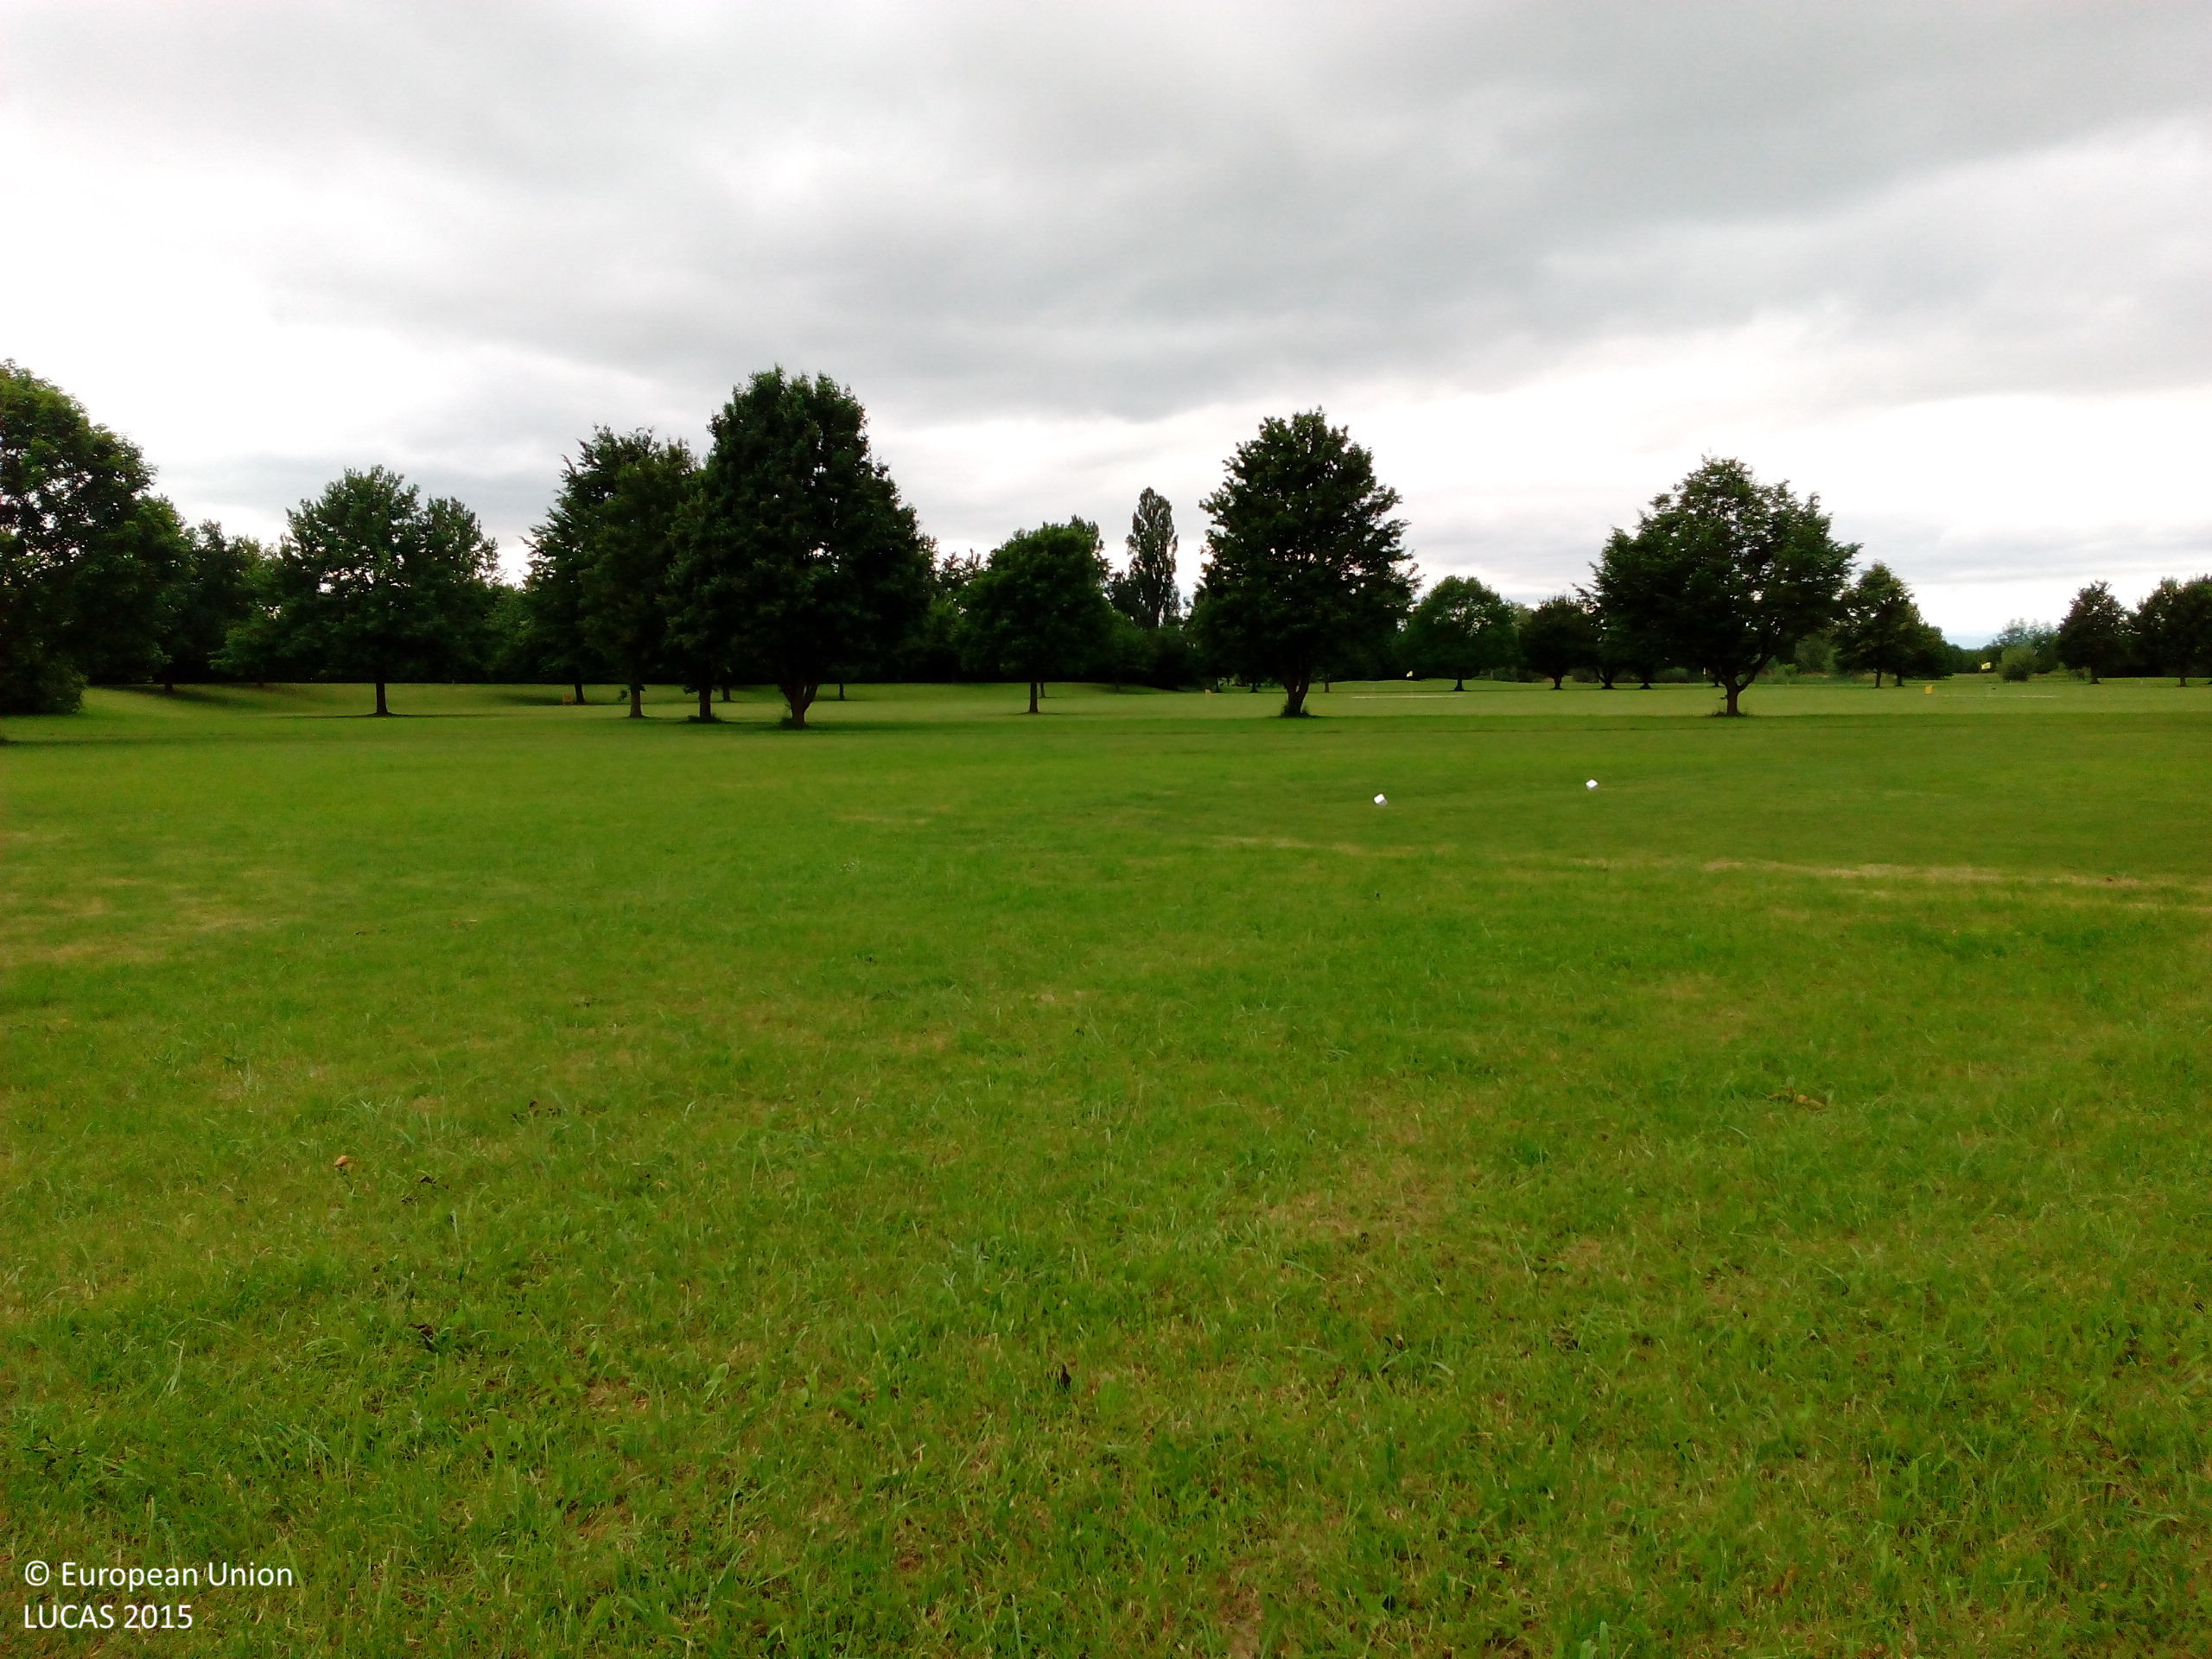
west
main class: Grassland
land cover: Grassland without tree/shrub cover
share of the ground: > 75 %
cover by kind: herbaceous plants 100 %
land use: Sport
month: May
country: DE
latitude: 47.9652
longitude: 7.6841
